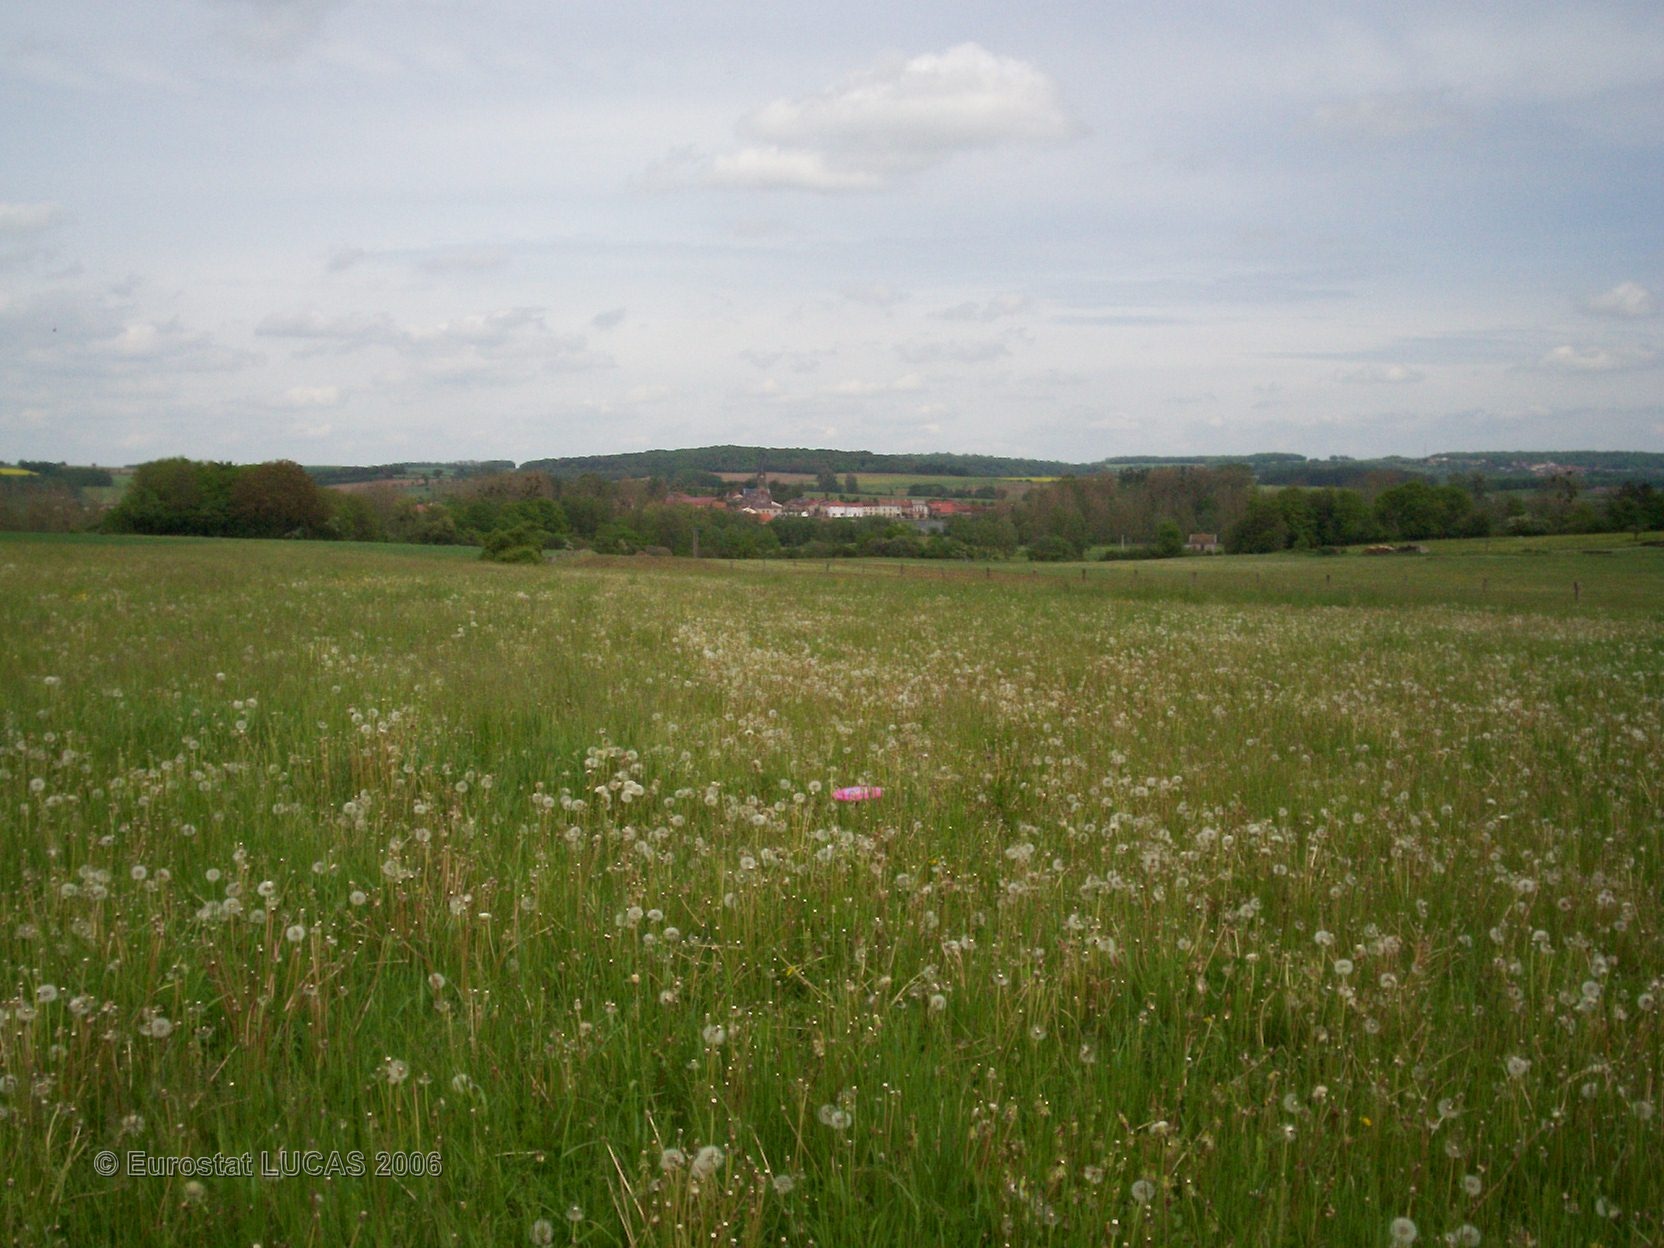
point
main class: Grassland
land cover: Grassland without tree/shrub cover
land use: Agriculture (excluding fallow land and kitchen gardens)
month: May
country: FR
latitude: 48.4398
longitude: 6.5535
